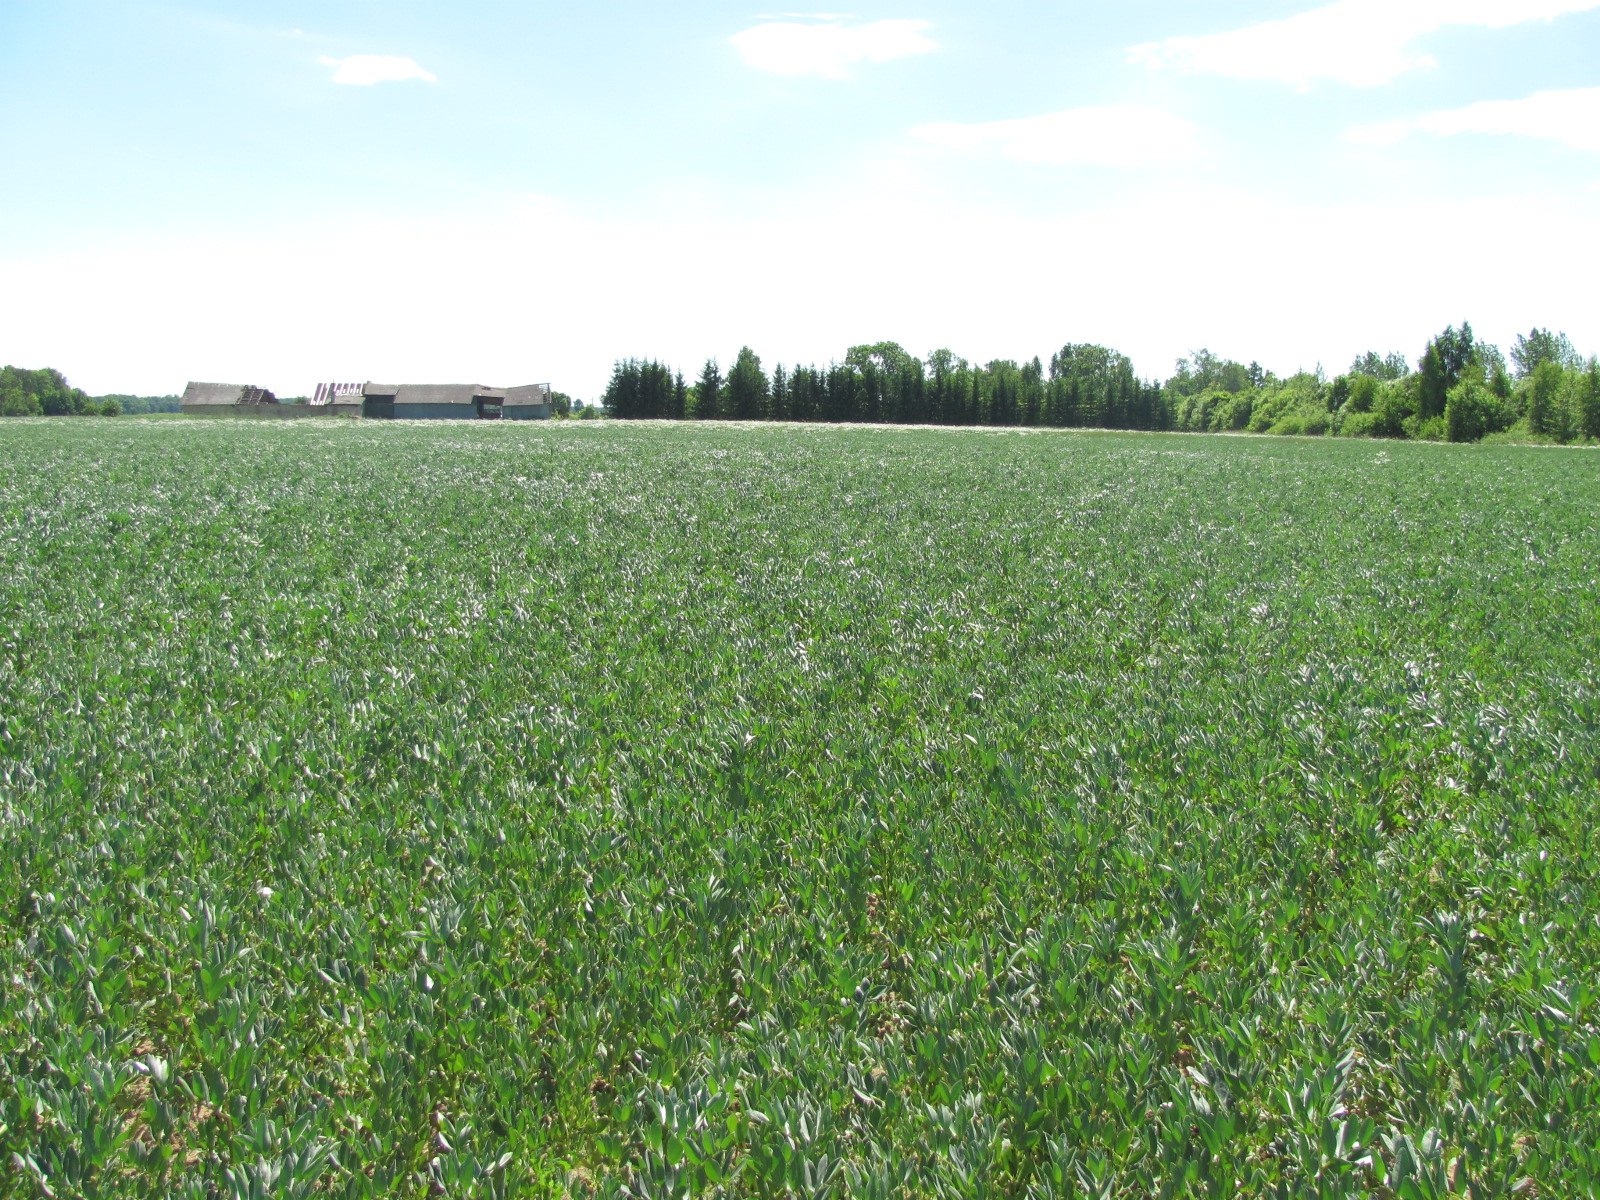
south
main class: Cropland
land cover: Dry pulses
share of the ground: > 75 %
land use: Agriculture (excluding fallow land and kitchen gardens)
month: July
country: LV
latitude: 56.4539
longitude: 23.6924
